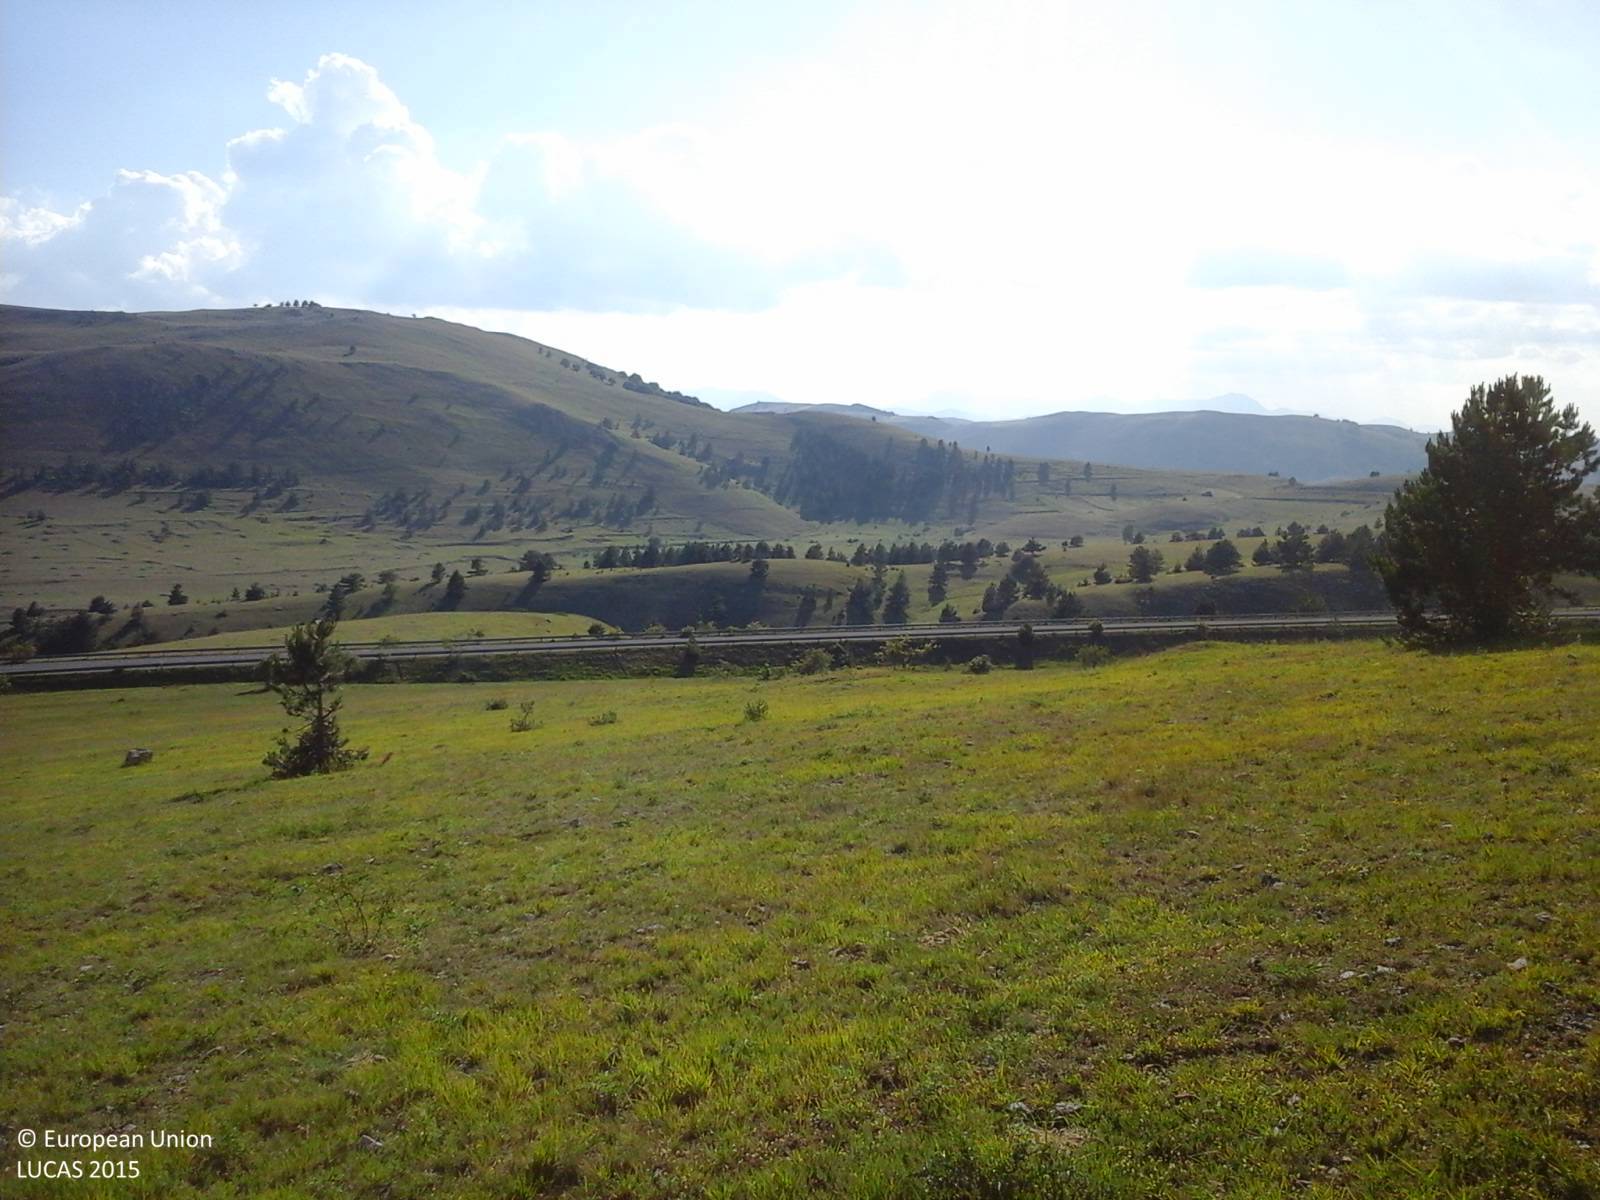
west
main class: Grassland
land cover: Grassland with sparse tree/shrub cover
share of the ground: > 75 %
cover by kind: herbaceous plants 95 %, coniferous forest trees 5 %
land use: Agriculture (excluding fallow land and kitchen gardens)
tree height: < 5 m
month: July
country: IT
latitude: 42.4530
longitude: 13.3818
